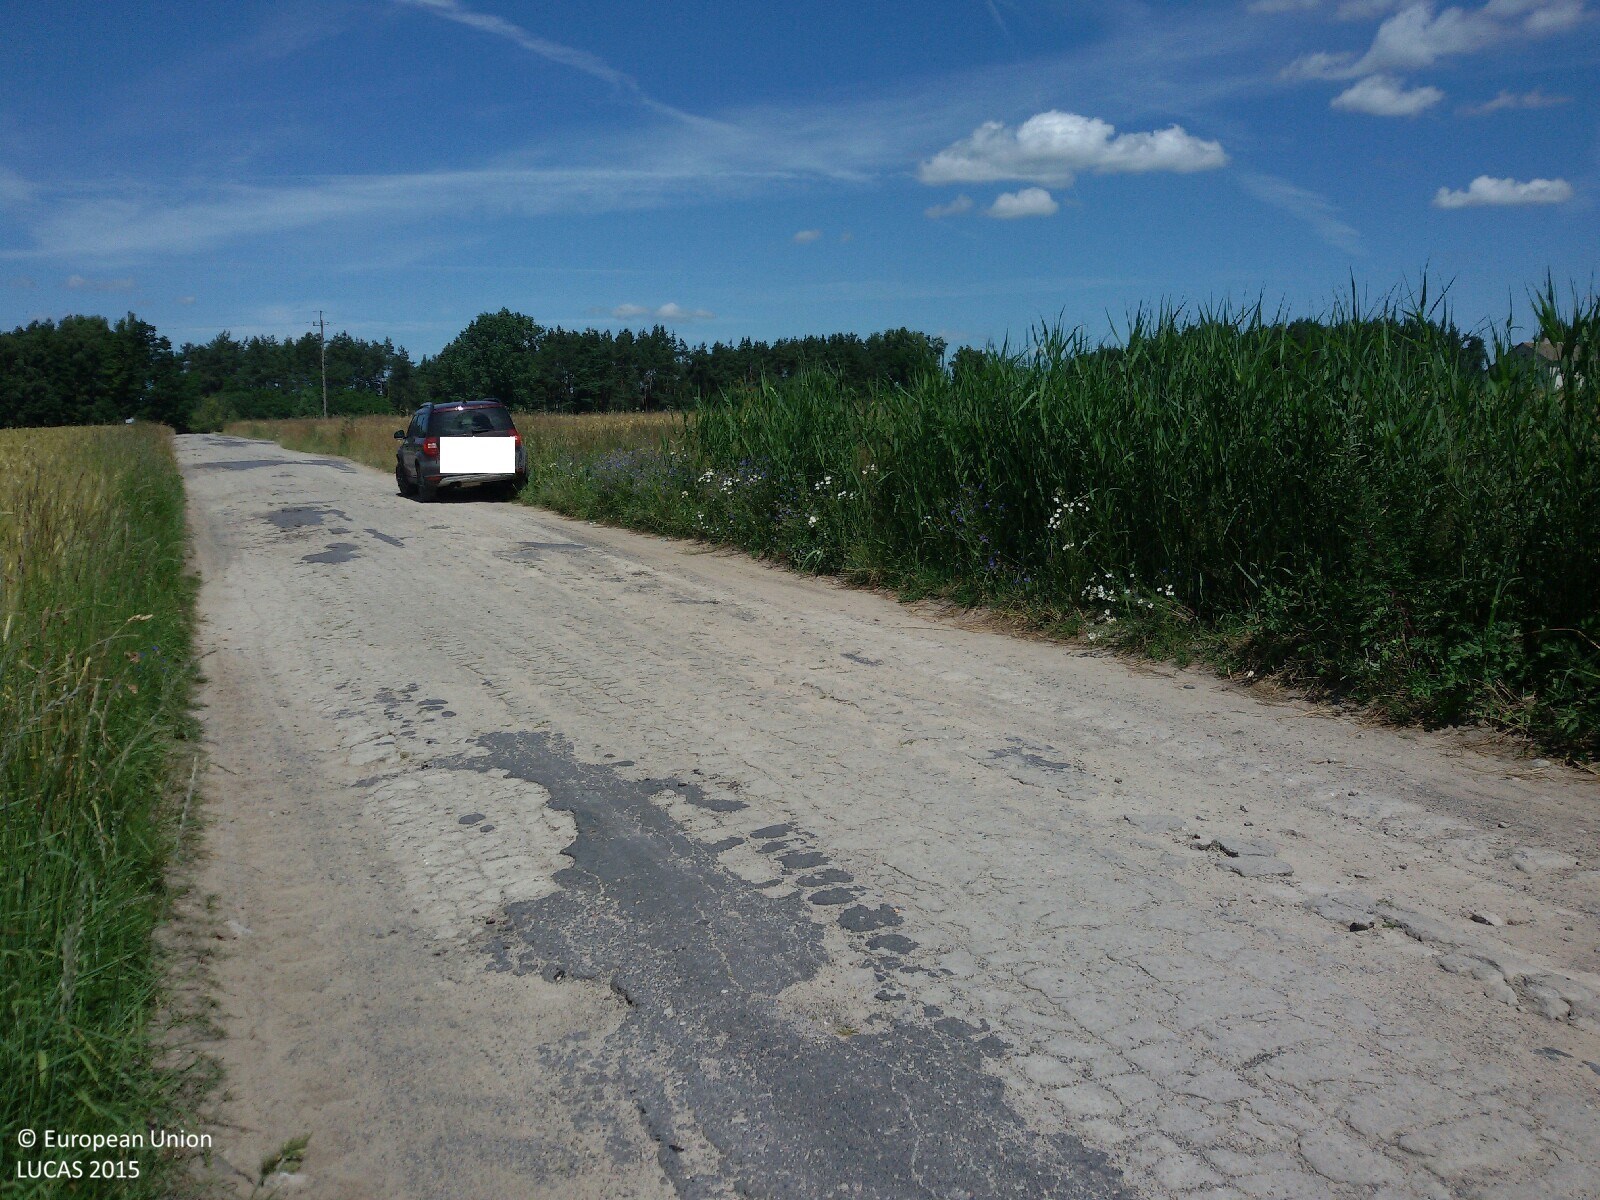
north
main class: Cropland
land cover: Rye
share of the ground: > 75 %
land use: Agriculture (excluding fallow land and kitchen gardens)
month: July
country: PL
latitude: 51.7791
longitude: 21.6929
